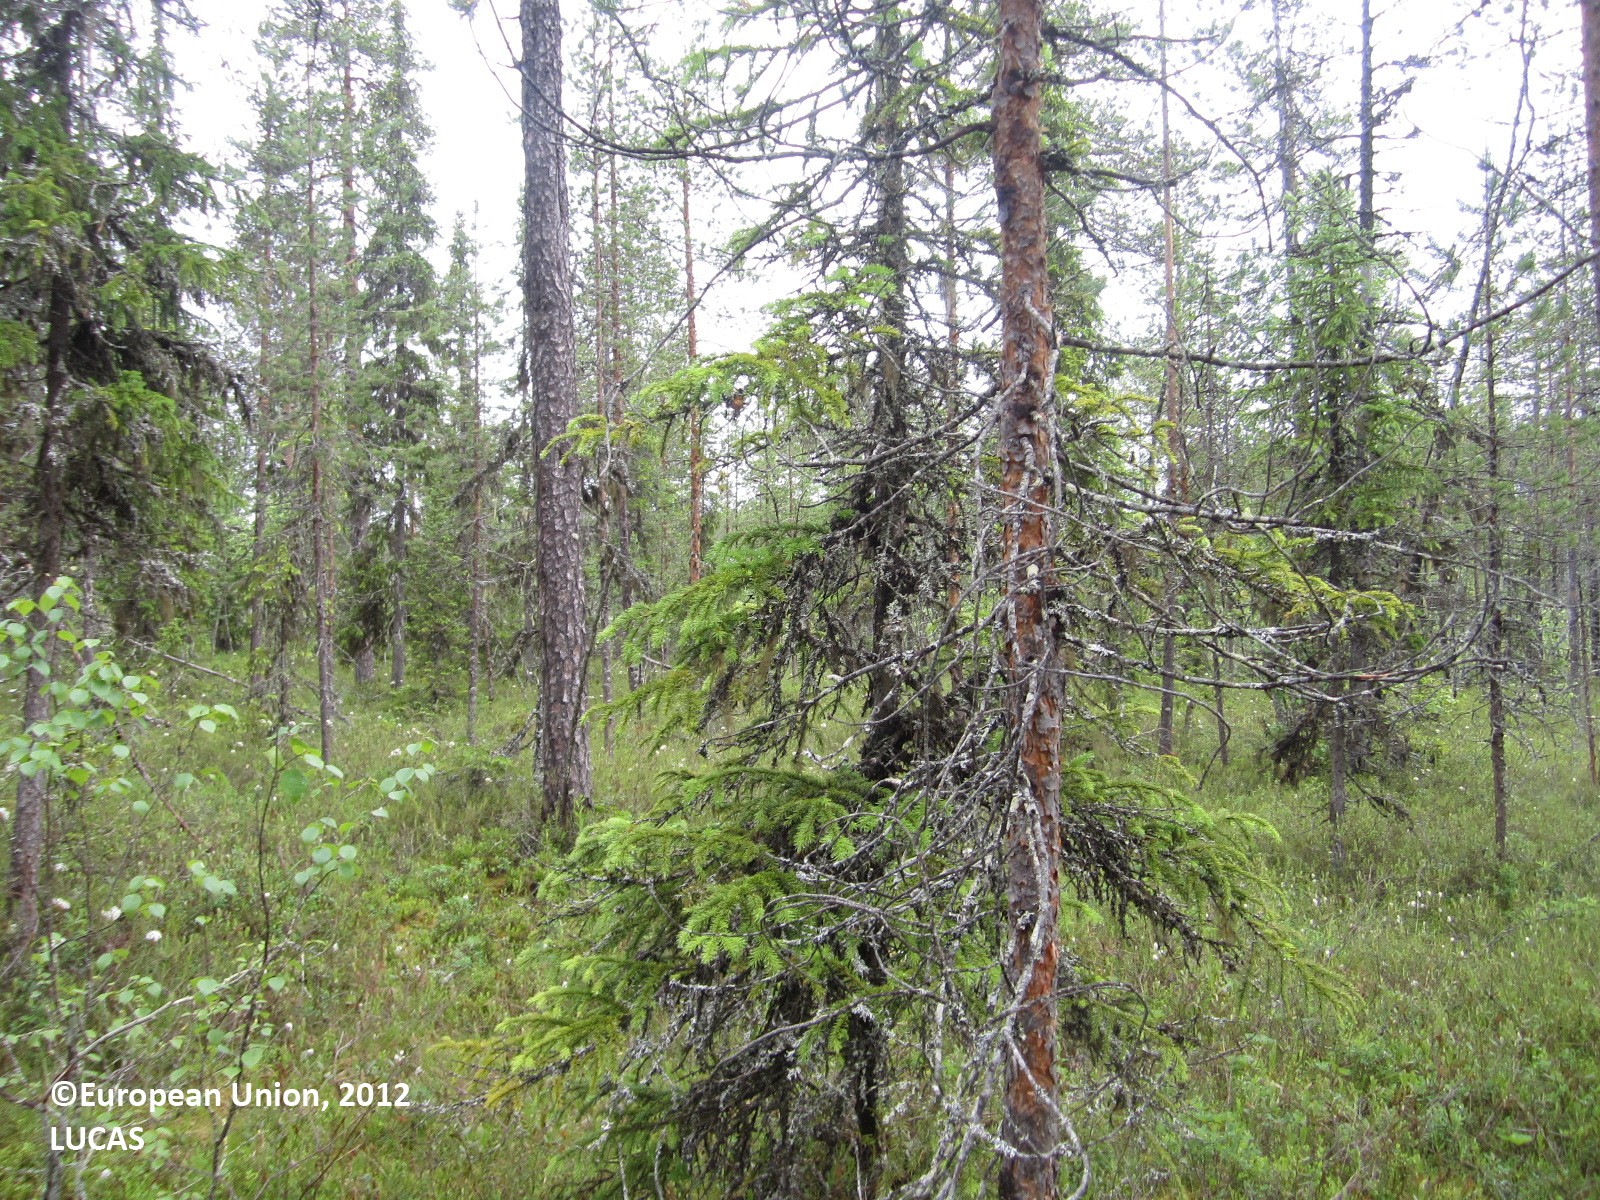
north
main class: Woodland
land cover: Spruce dominated coniferous woodland
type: mire and swamp forests
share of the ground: 50 - 75 %
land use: Forestry
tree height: > 5 m
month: June
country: FI
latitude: 64.5441
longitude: 29.5879
